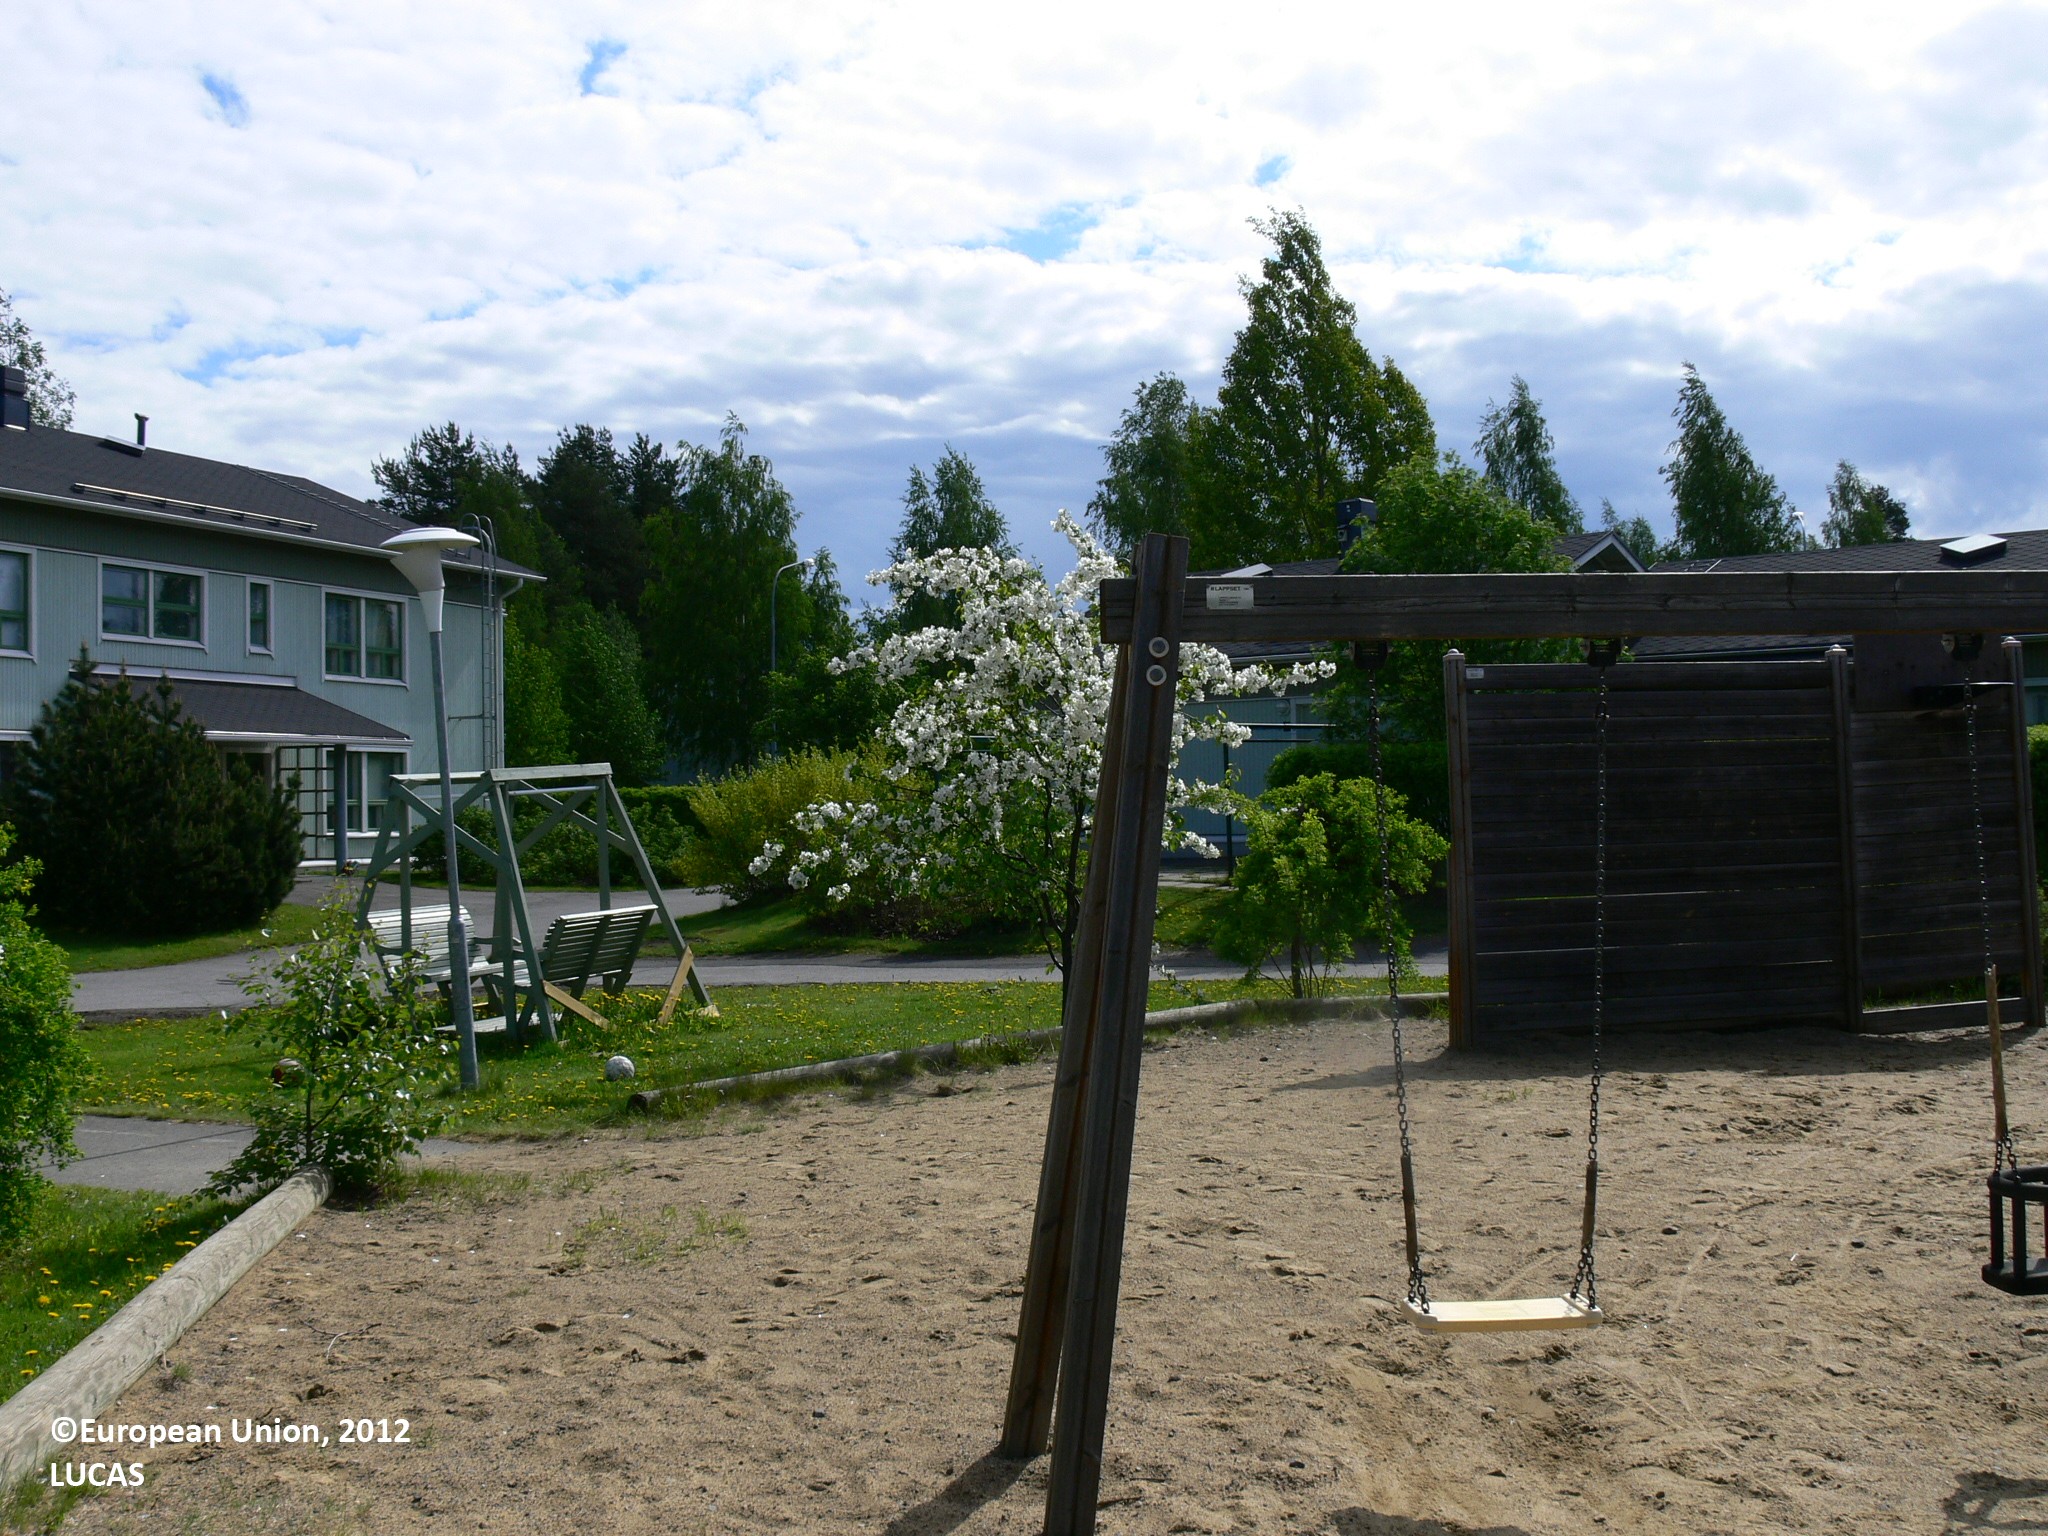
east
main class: Grassland
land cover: Grassland with sparse tree/shrub cover
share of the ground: 50 - 75 %
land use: Residential
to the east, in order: Grassland with sparse tree/shrub cover; Artificial constructions in urban areas
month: June
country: FI
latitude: 62.5996
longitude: 29.8268
